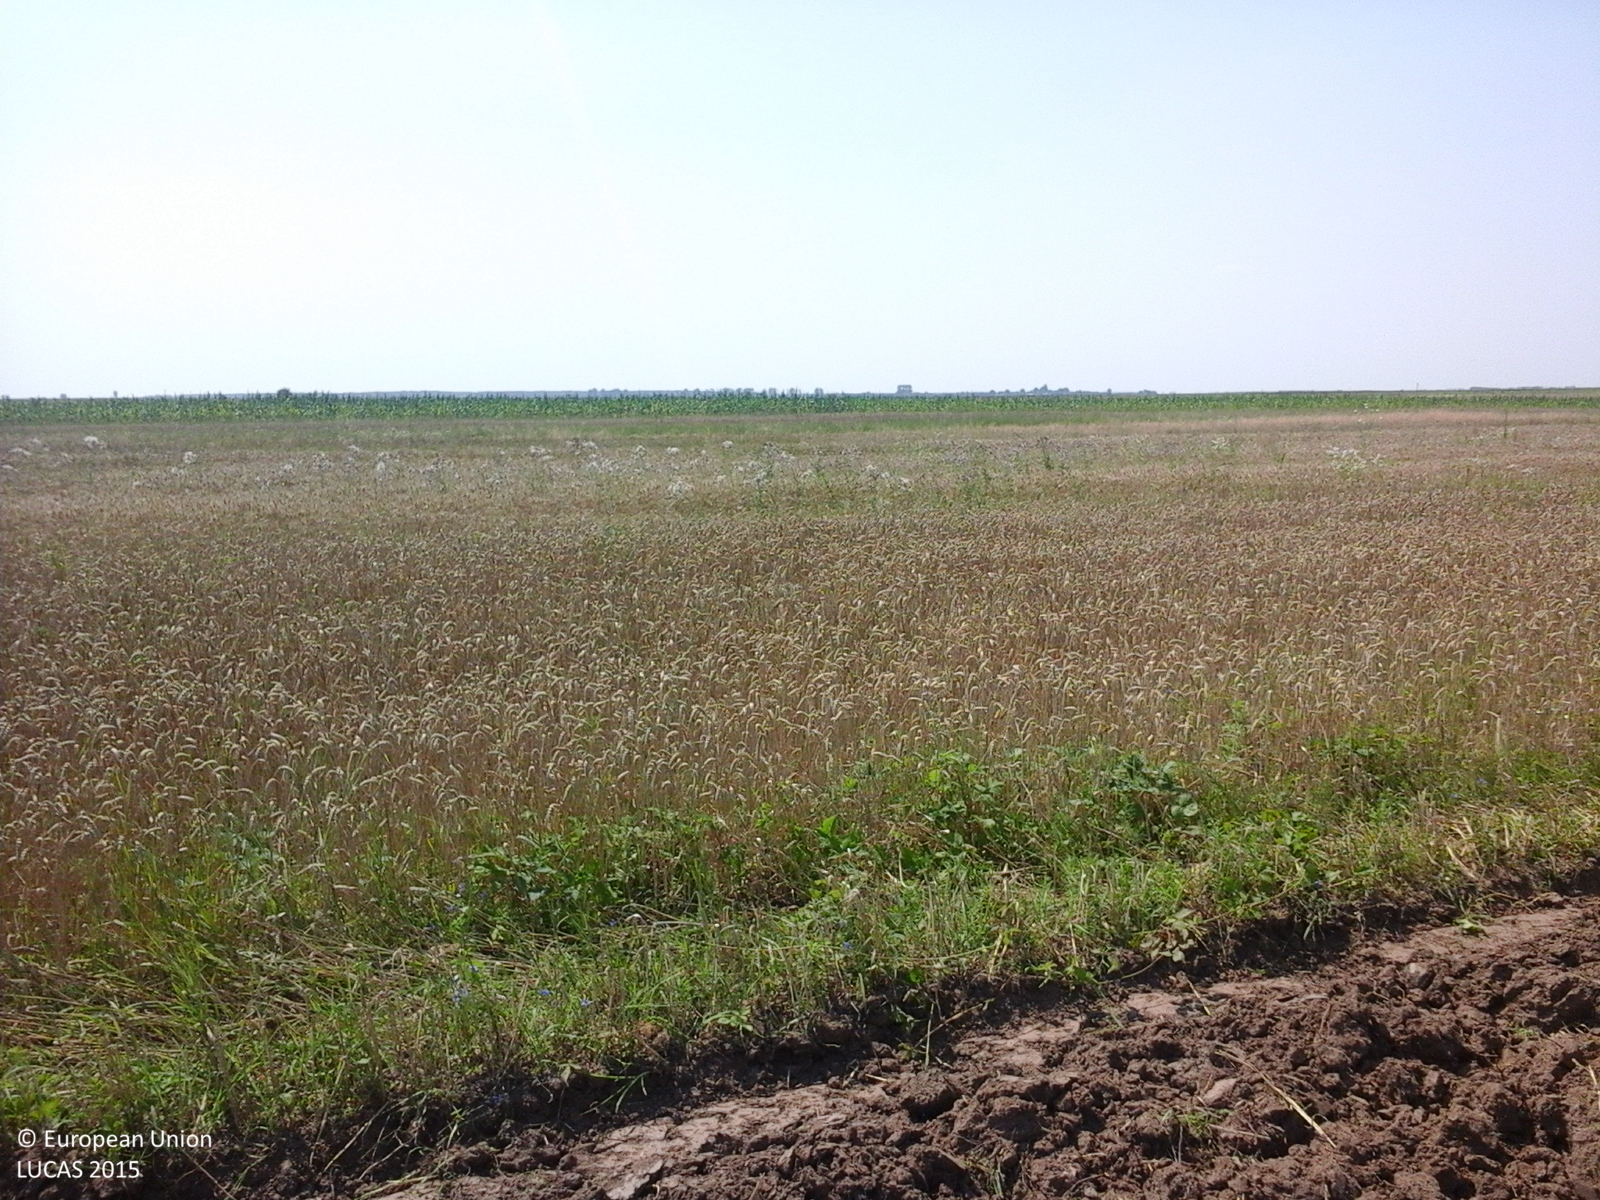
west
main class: Cropland
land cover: Barley
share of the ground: < 10 %
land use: Agriculture (excluding fallow land and kitchen gardens)
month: July
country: RO
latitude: 44.7305
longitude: 25.5374
